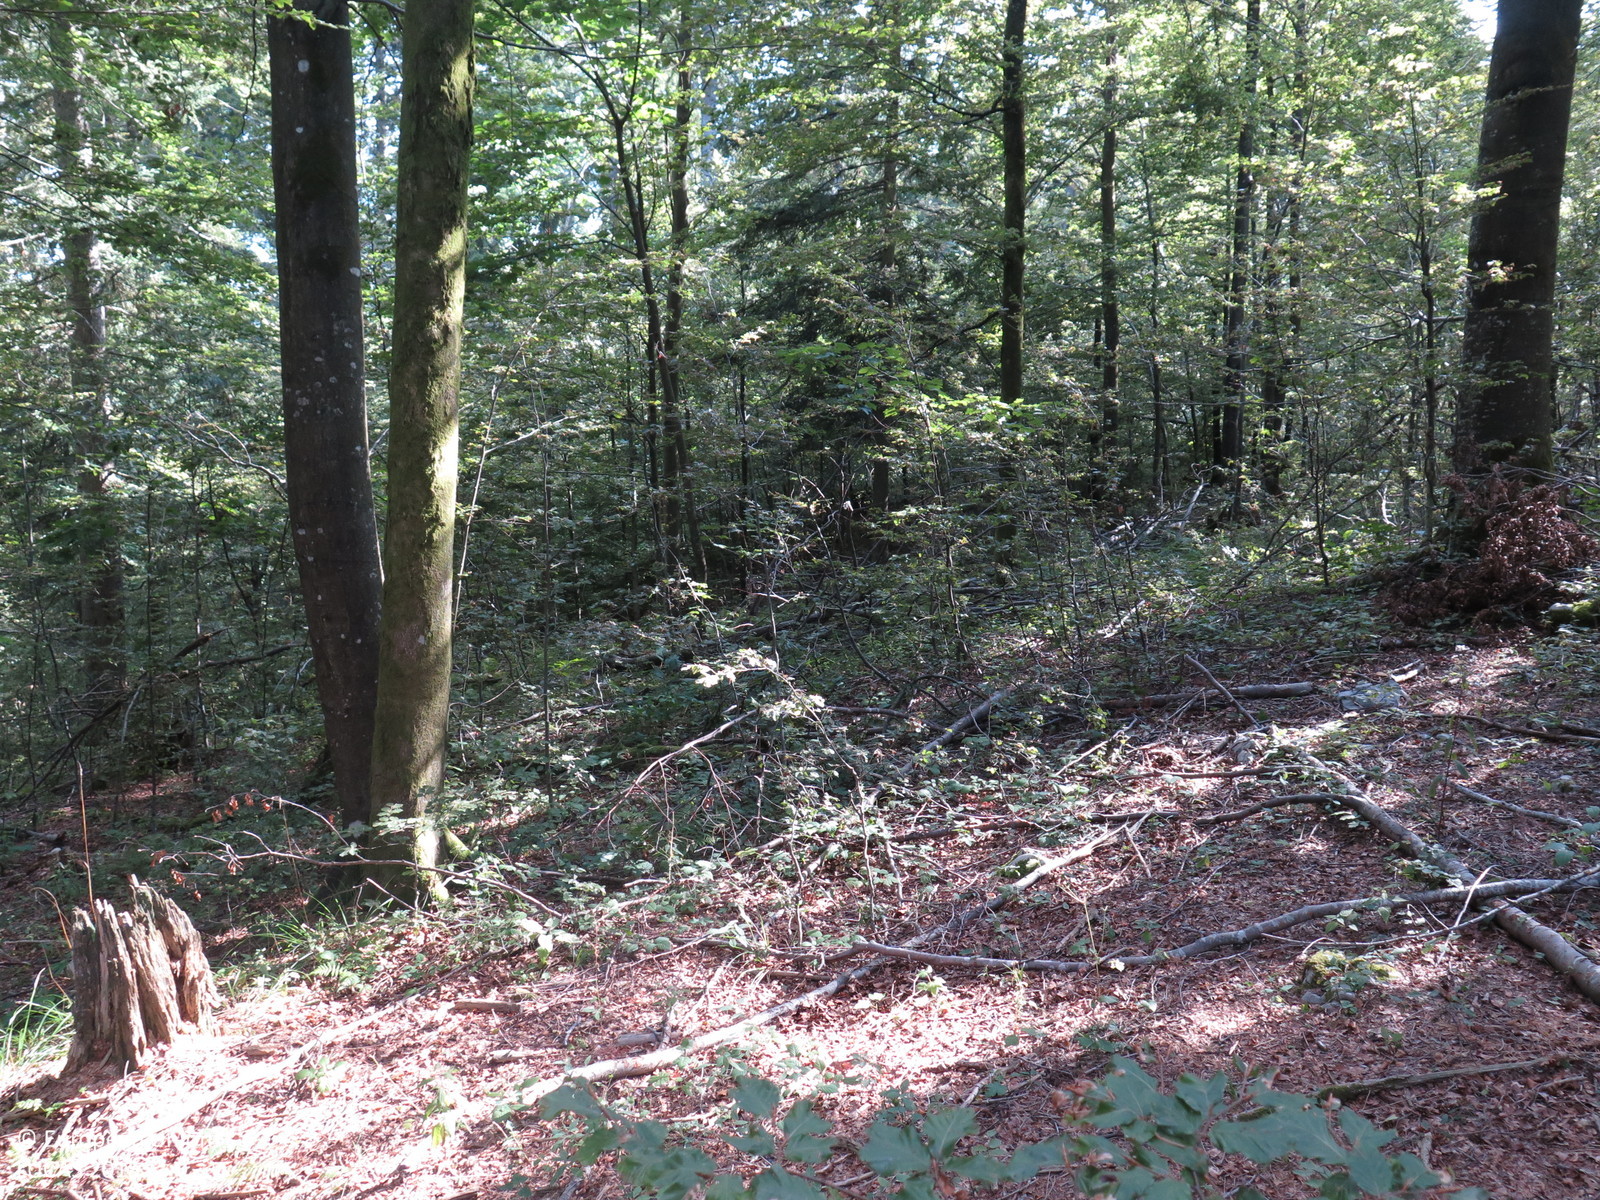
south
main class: Woodland
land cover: Other mixed woodland
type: alpine coniferous forest
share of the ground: > 75 %
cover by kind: coniferous forest trees 75 %, broadleaved forest trees 25 %
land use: Forestry
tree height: > 5 m
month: September
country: HR
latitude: 45.4151
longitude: 14.7616
